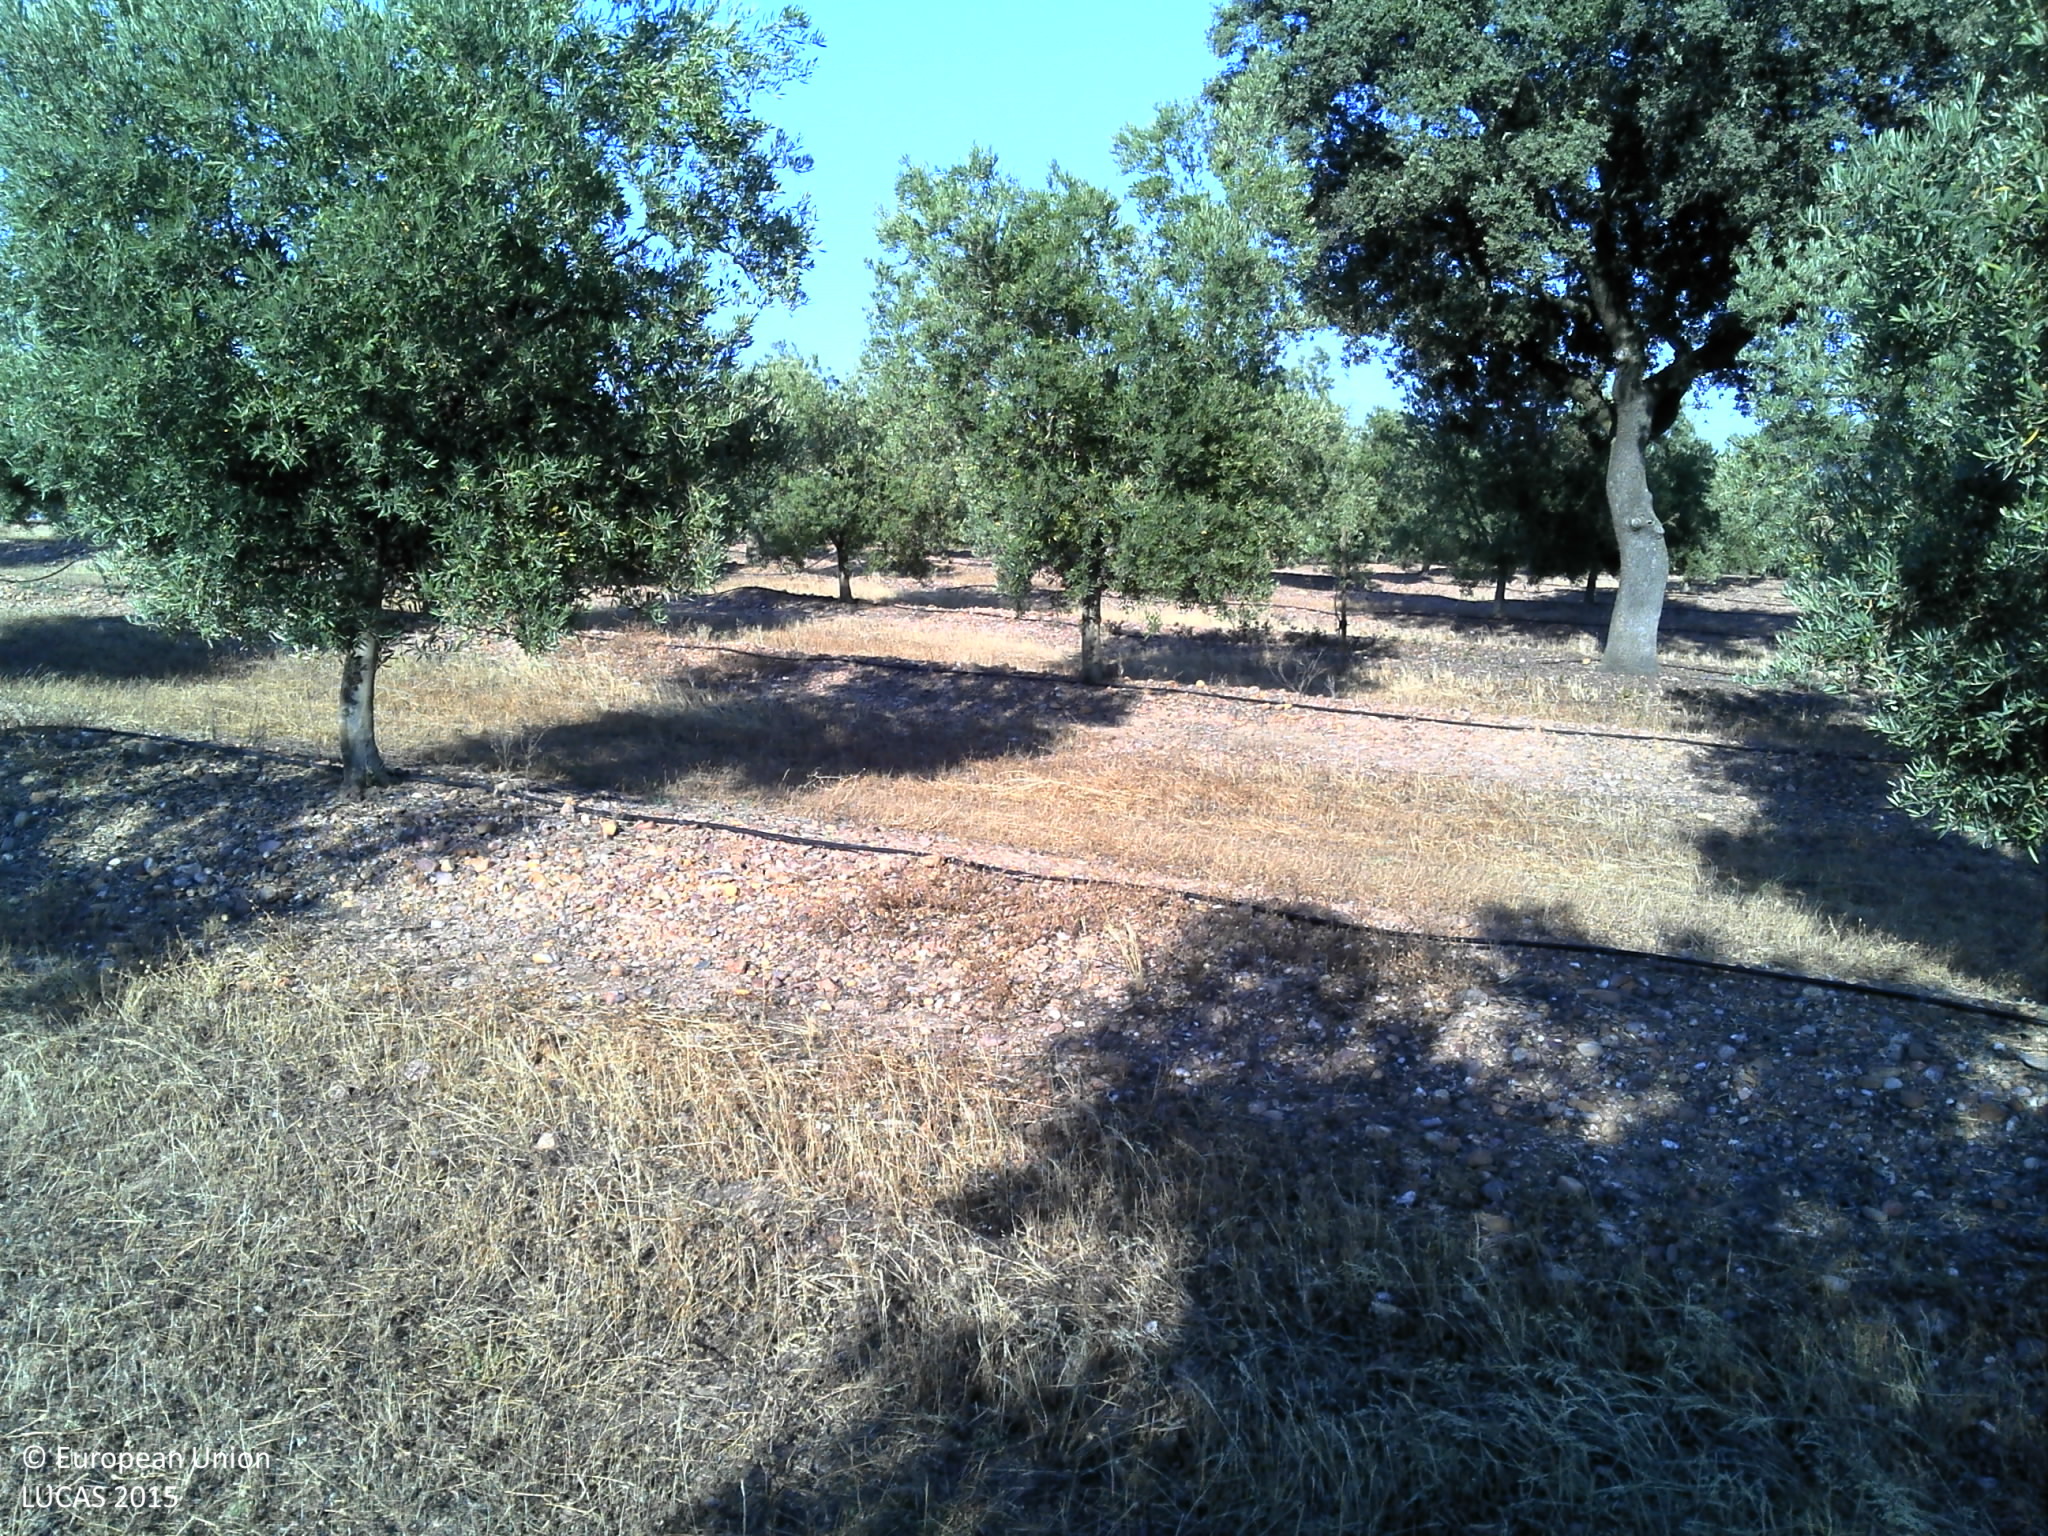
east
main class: Cropland
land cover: Olive groves
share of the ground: 25 - 50 %
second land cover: Grassland without tree/shrub cover
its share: 10 - 25 %
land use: Agriculture (excluding fallow land and kitchen gardens)
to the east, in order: Olive groves; Grassland without tree/shrub cover; Olive groves; Tracks; Grass margins; Fences; Other structural elements; Grassland without tree/shrub cover
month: June
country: PT
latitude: 38.1517
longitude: -7.5630
